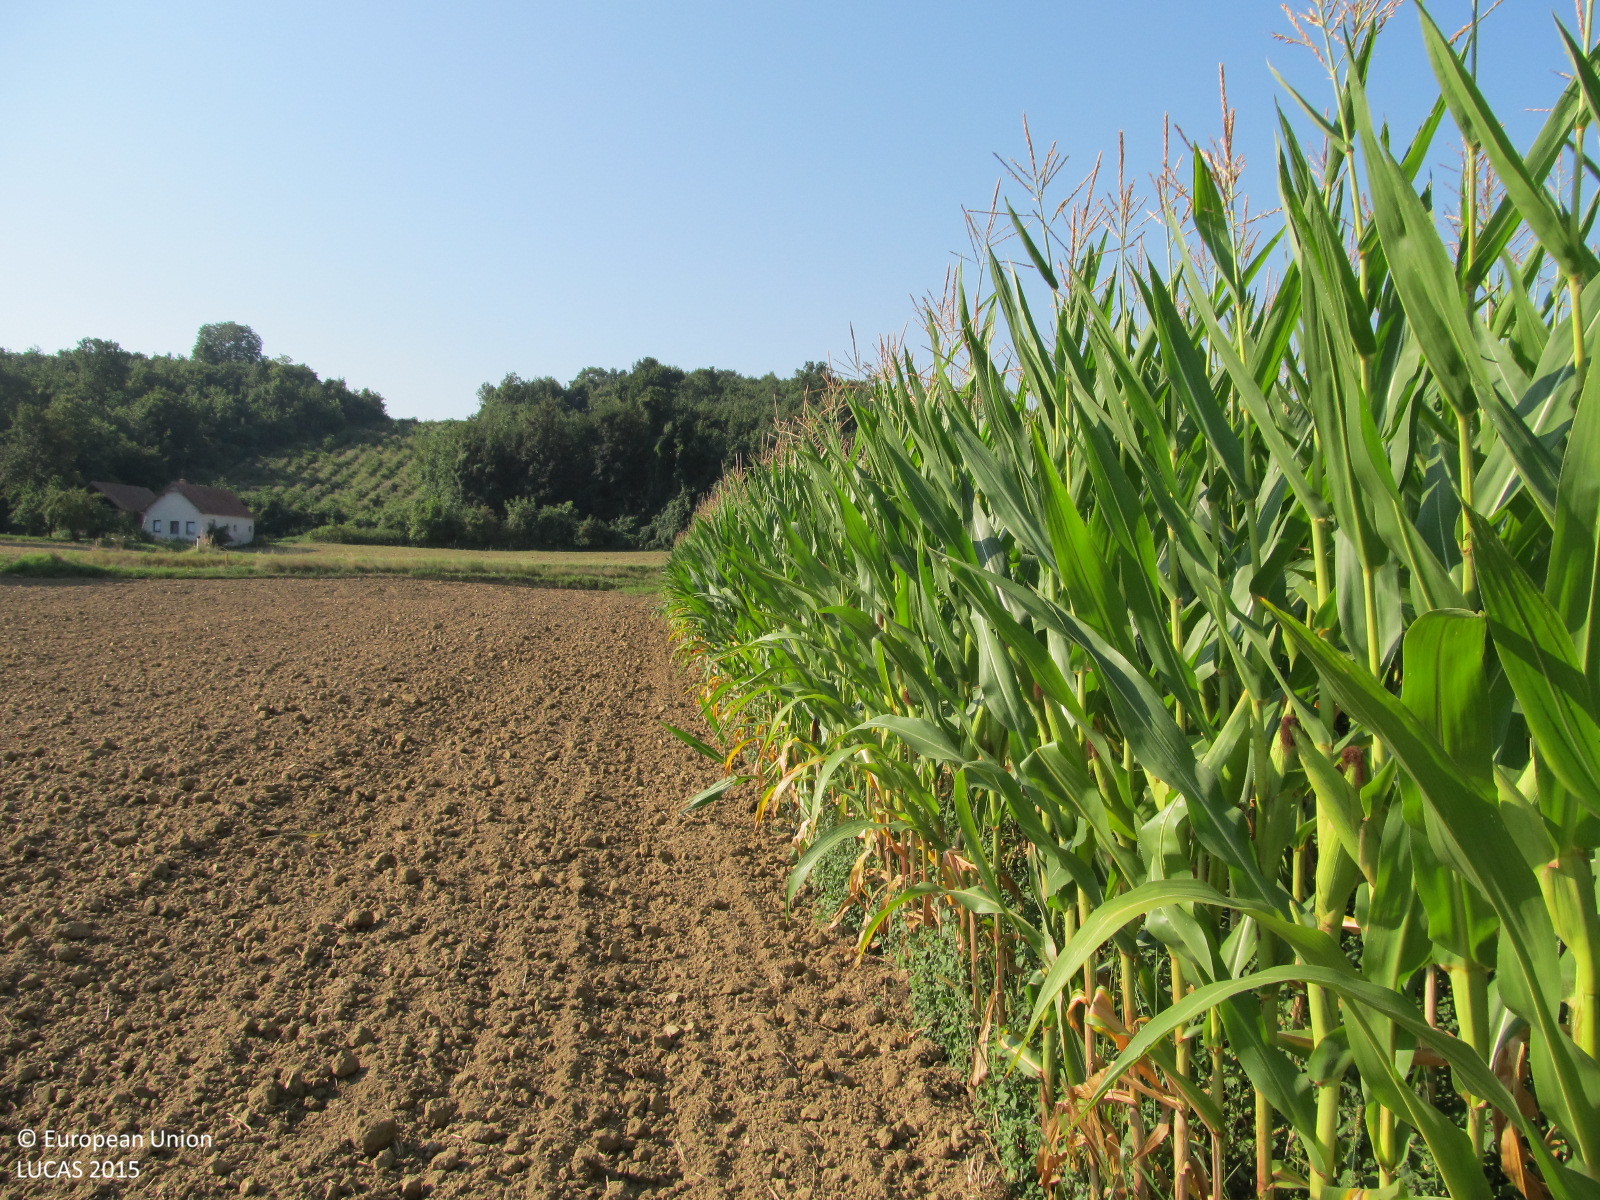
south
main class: Cropland
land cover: Maize
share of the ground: > 75 %
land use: Agriculture (excluding fallow land and kitchen gardens)
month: August
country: AT
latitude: 48.3032
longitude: 15.8410
